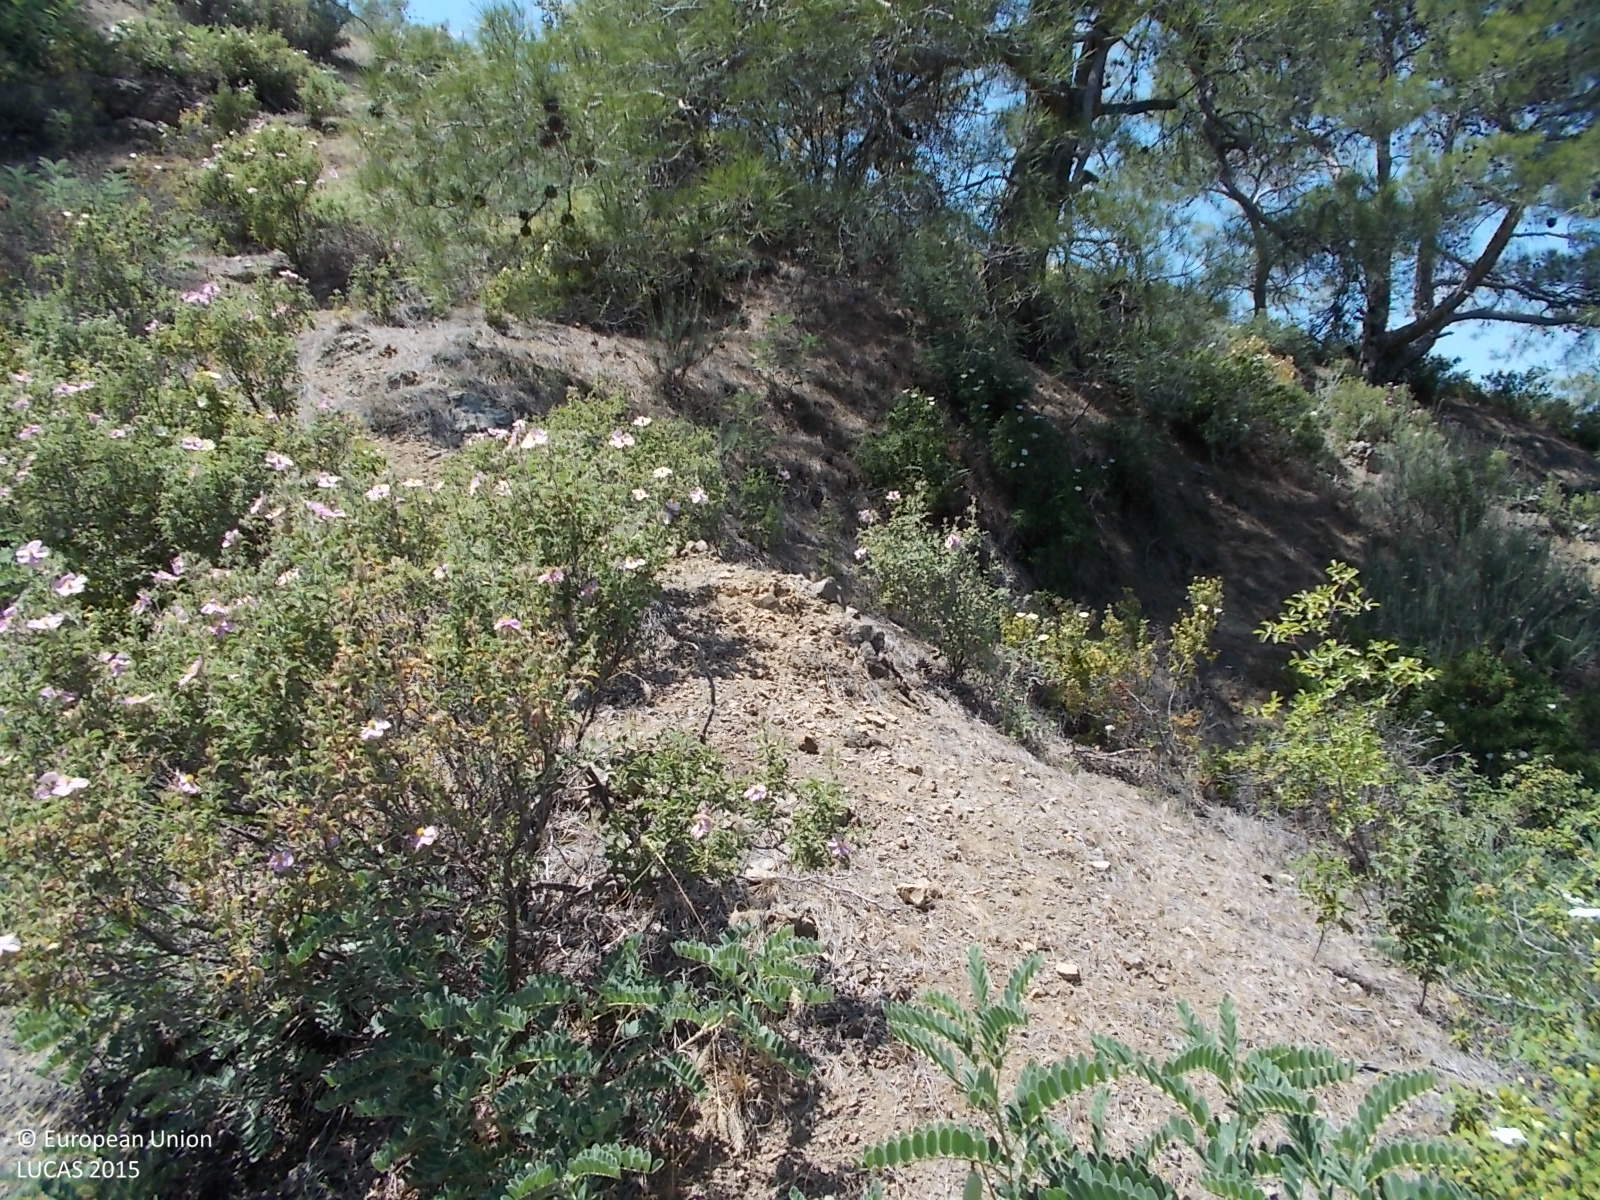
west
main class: Woodland
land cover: Pine dominated coniferous woodland
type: coniferous forest of the mediterranean region
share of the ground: 25 - 50 %
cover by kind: coniferous forest trees 40 %, shrubs 40 %, unconsolidated bare surface 20 %
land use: Semi-natural and natural areas not in use
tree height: > 5 m
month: May
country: CY
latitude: 34.8409
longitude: 33.0364
